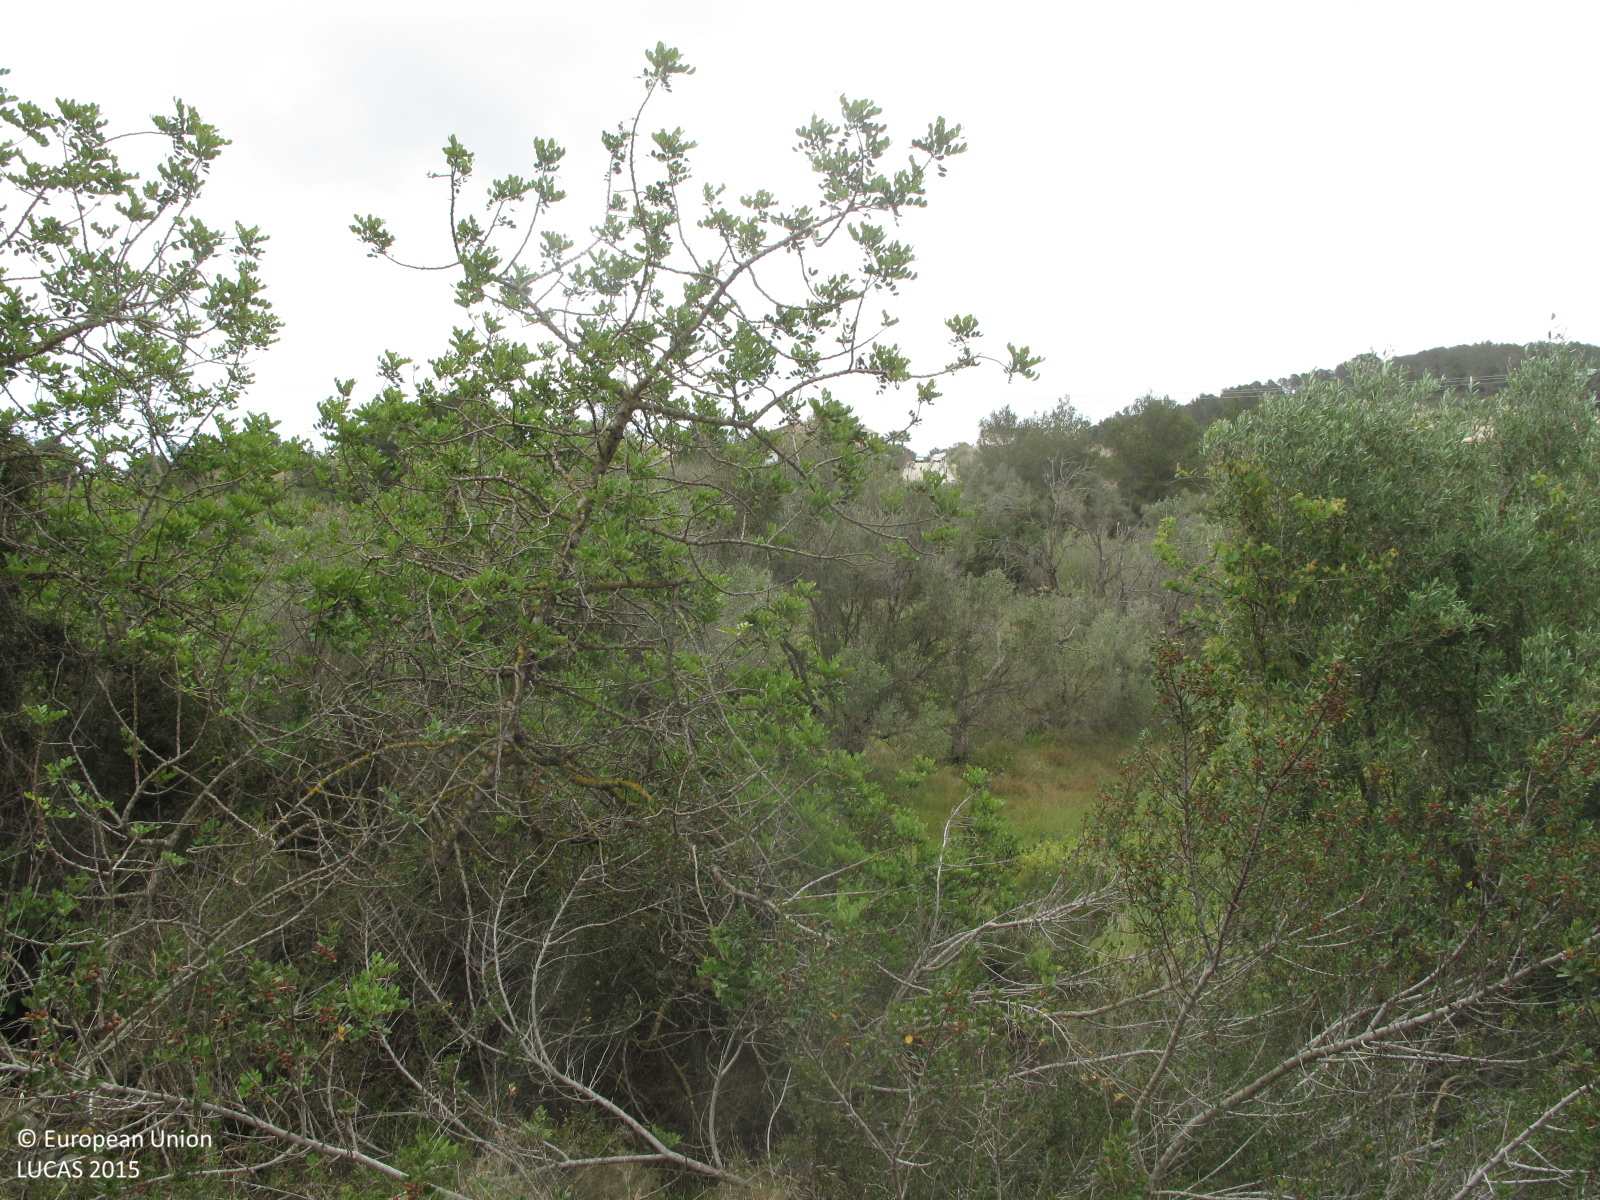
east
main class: Cropland
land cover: Permanent industrial crops
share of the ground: 10 - 25 %
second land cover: Spontaneously vegetated surfaces
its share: > 75 %
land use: Agriculture (excluding fallow land and kitchen gardens)
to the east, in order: Tracks; Broadleaved woodland; Olive groves; Vineyards; Electric lines; Vineyards; Grassland with sparse tree/shrub cover; Broadleaved woodland; Dry stone walls; Grassland with sparse tree/shrub cover; Artificial constructions; Shrubland with sparse tree cover; Artificial constructions in urban areas
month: May
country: ES
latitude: 38.7678
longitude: 0.1486
